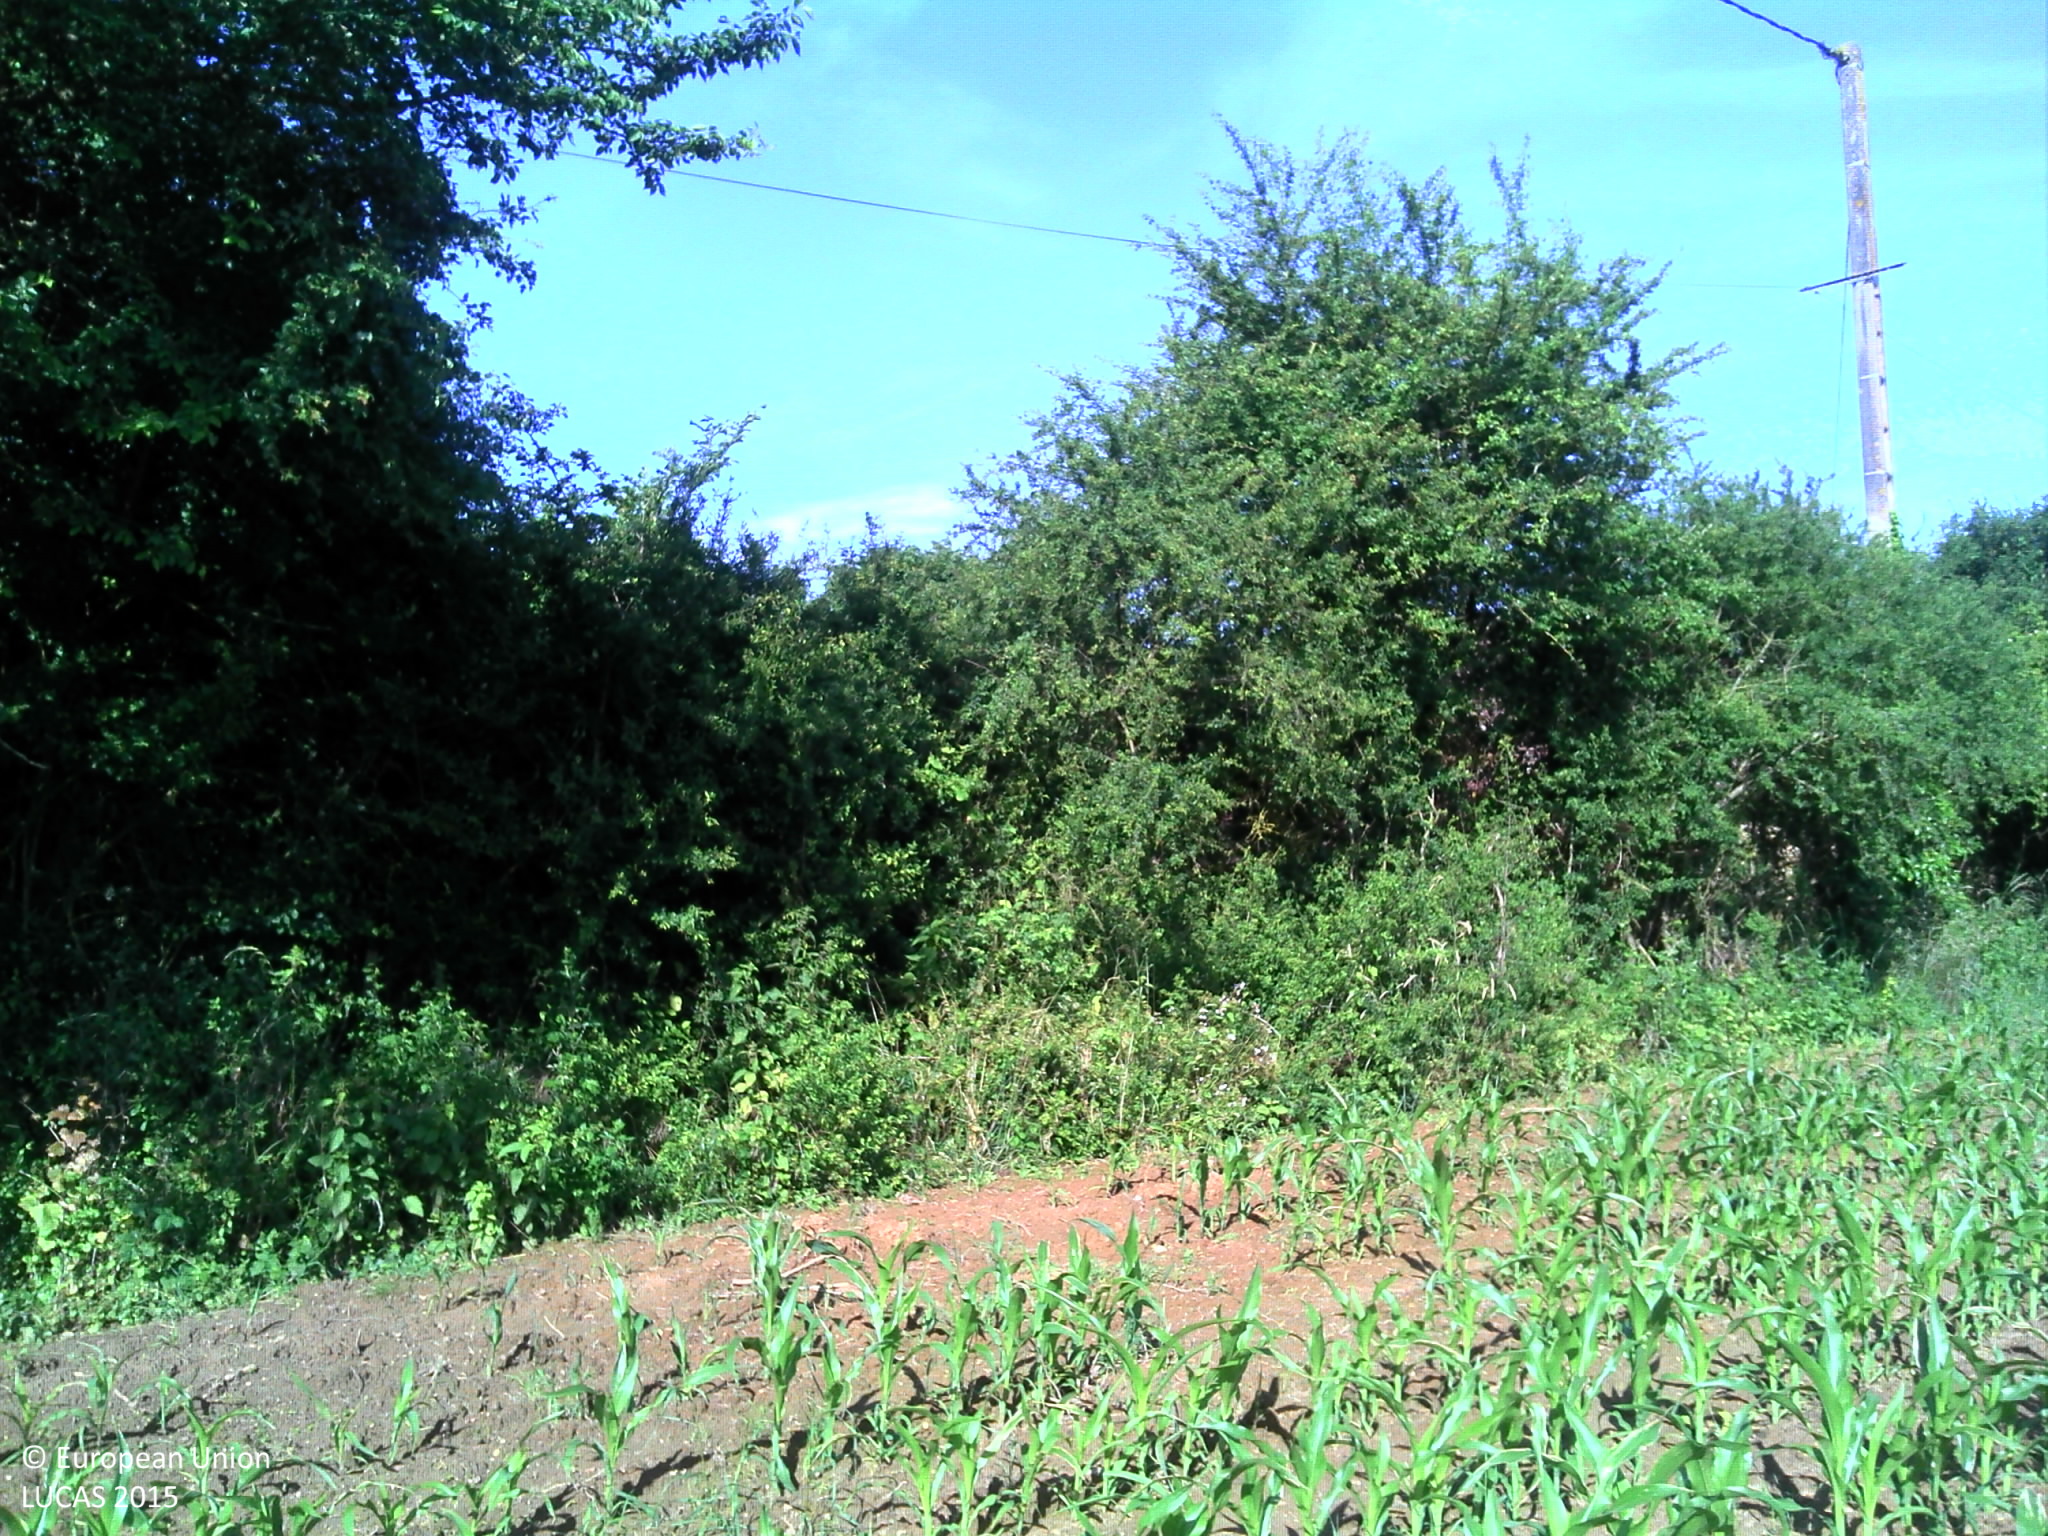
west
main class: Cropland
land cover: Maize
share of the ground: > 75 %
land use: Agriculture (excluding fallow land and kitchen gardens)
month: June
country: FR
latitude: 48.0286
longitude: 0.2792
